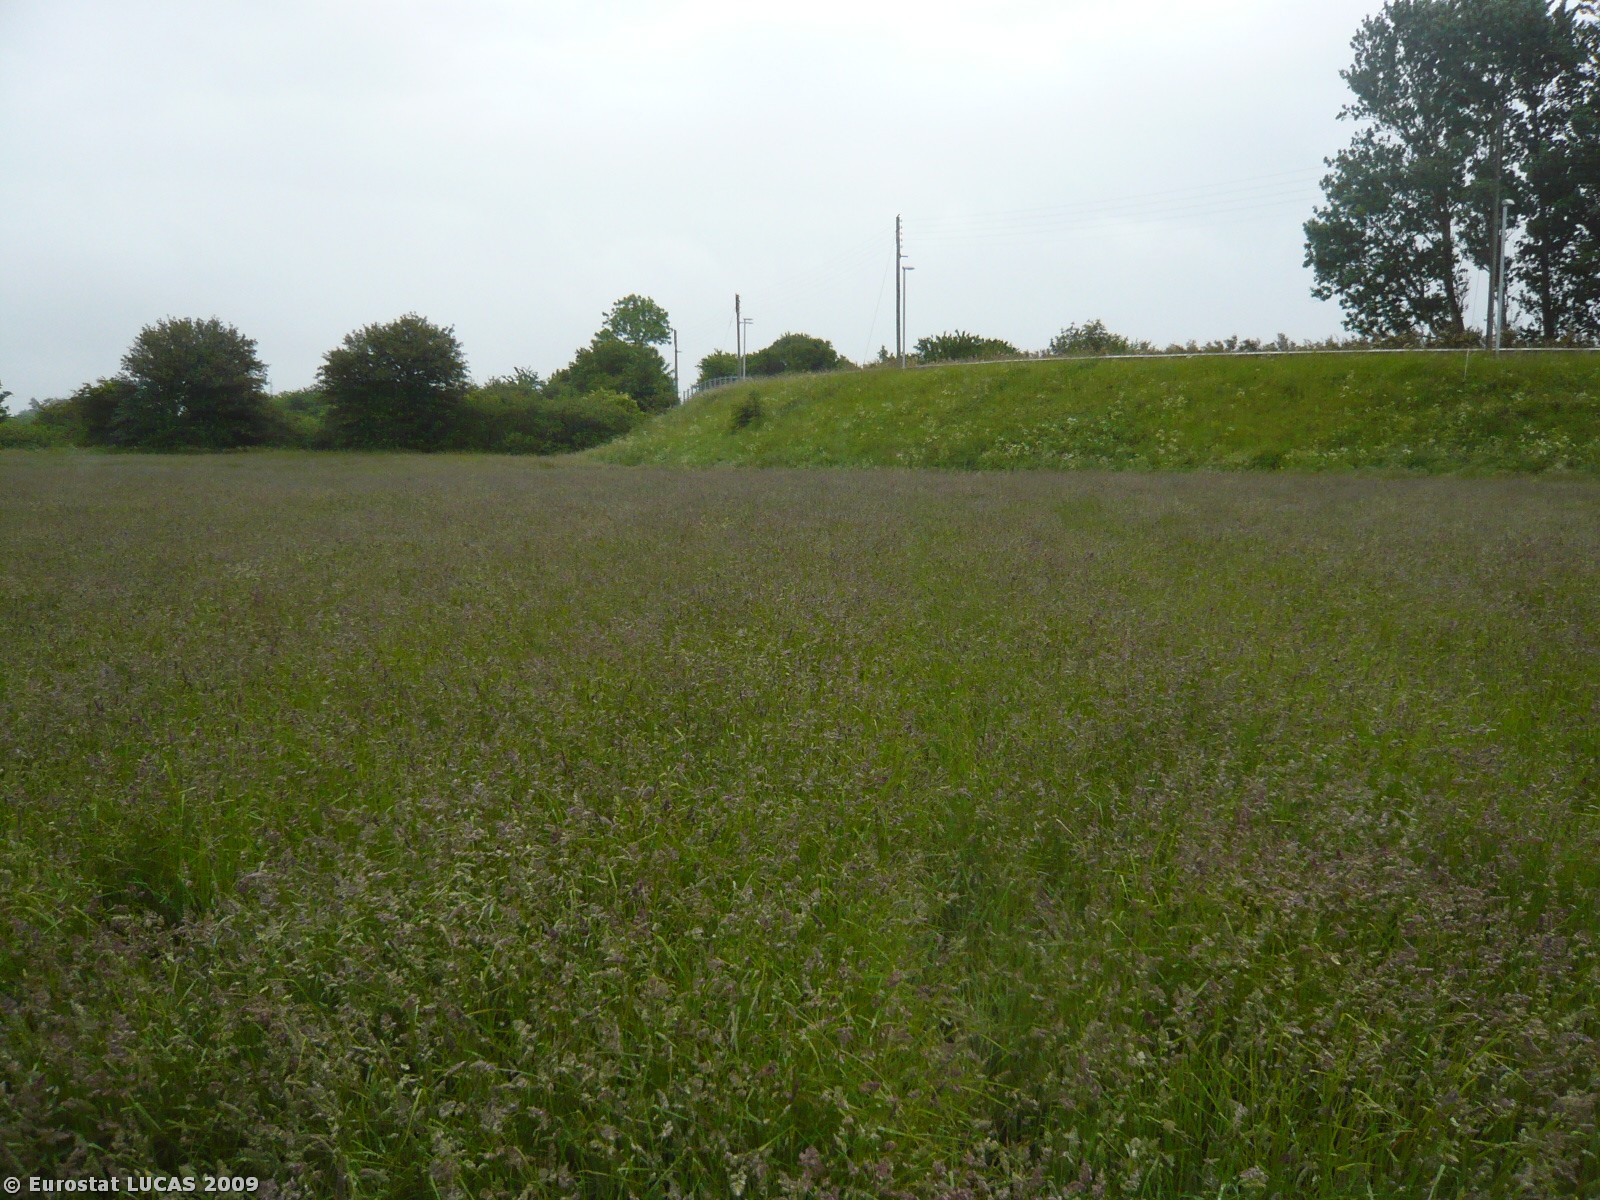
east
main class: Cropland
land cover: Temporary grasslands
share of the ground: > 75 %
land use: Agriculture (excluding fallow land and kitchen gardens)
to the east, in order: Temporary grasslands; Grassland without tree/shrub cover; Broadleaved woodland; Ditches and canals; Railways; Grass margins; Ditches and canals; Broadleaved woodland; Grass margins; Paved roads, cycling and walking lanes; Grass margins; Paved roads, cycling and walking lanes; Fences; Spontaneously vegetated surfaces
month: June
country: DK
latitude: 54.8614
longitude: 11.8839
